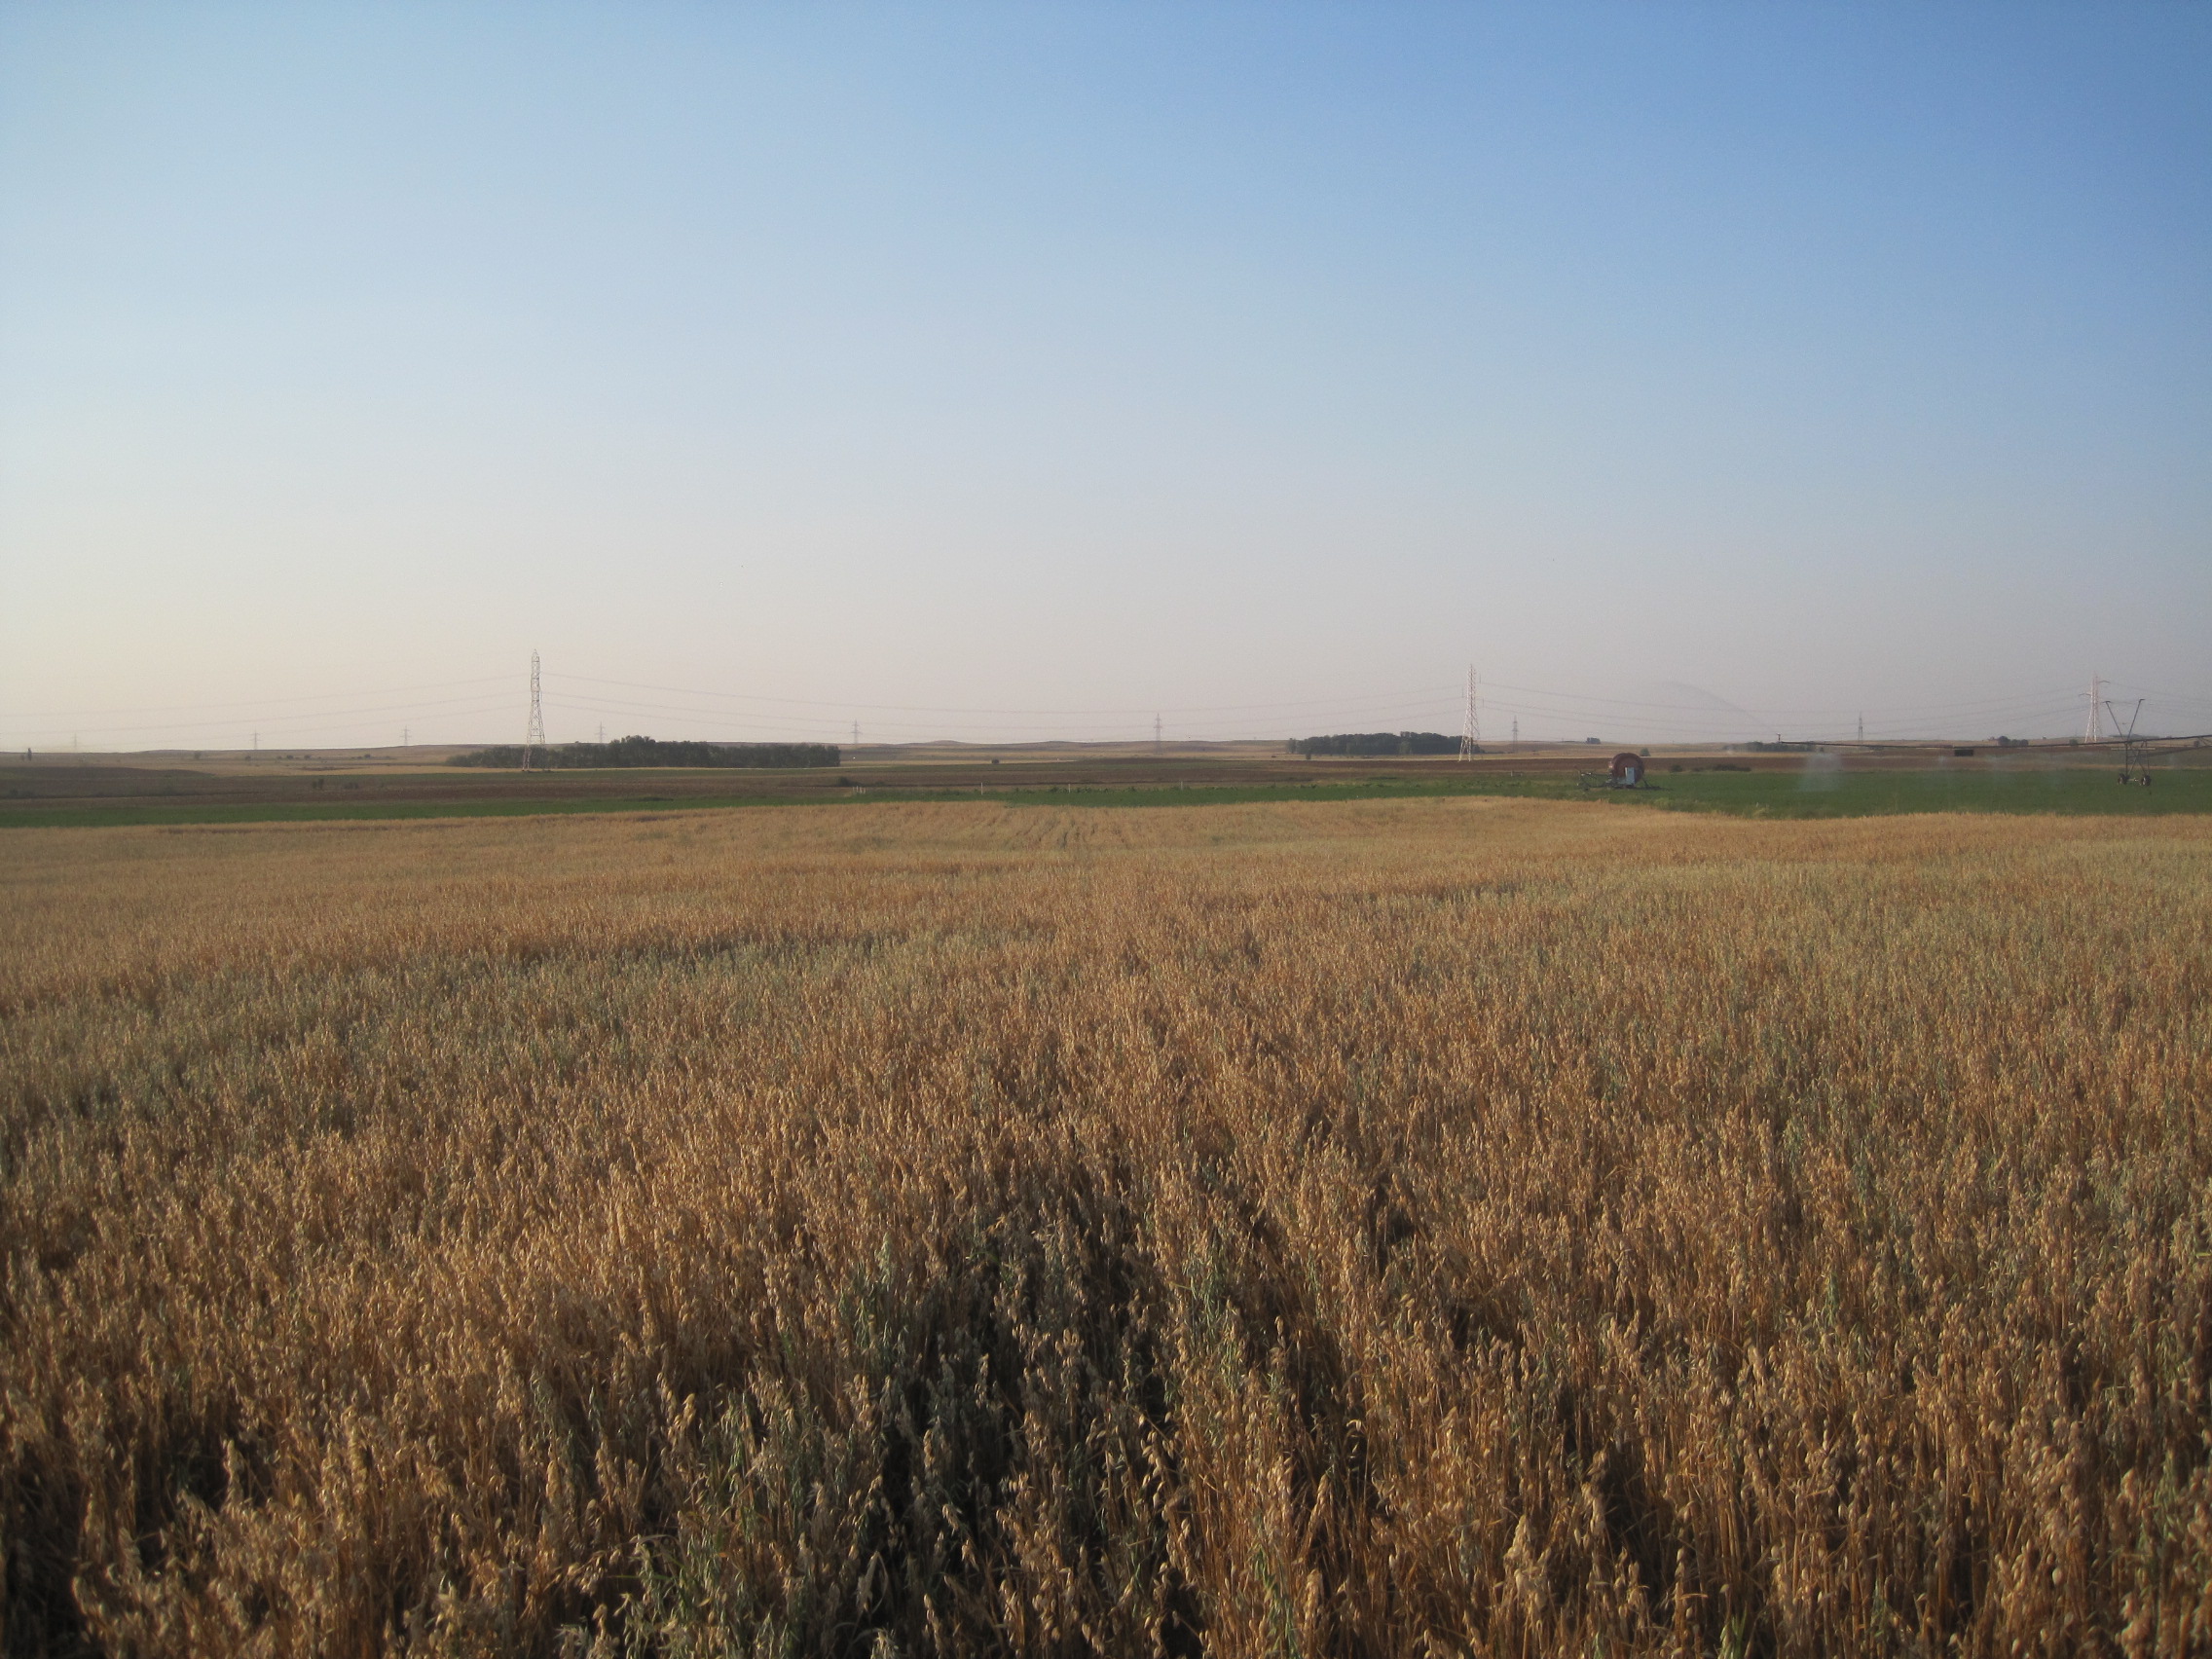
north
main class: Cropland
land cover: Oats
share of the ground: > 75 %
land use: Agriculture (excluding fallow land and kitchen gardens)
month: July
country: ES
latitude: 41.8696
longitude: -5.1765
